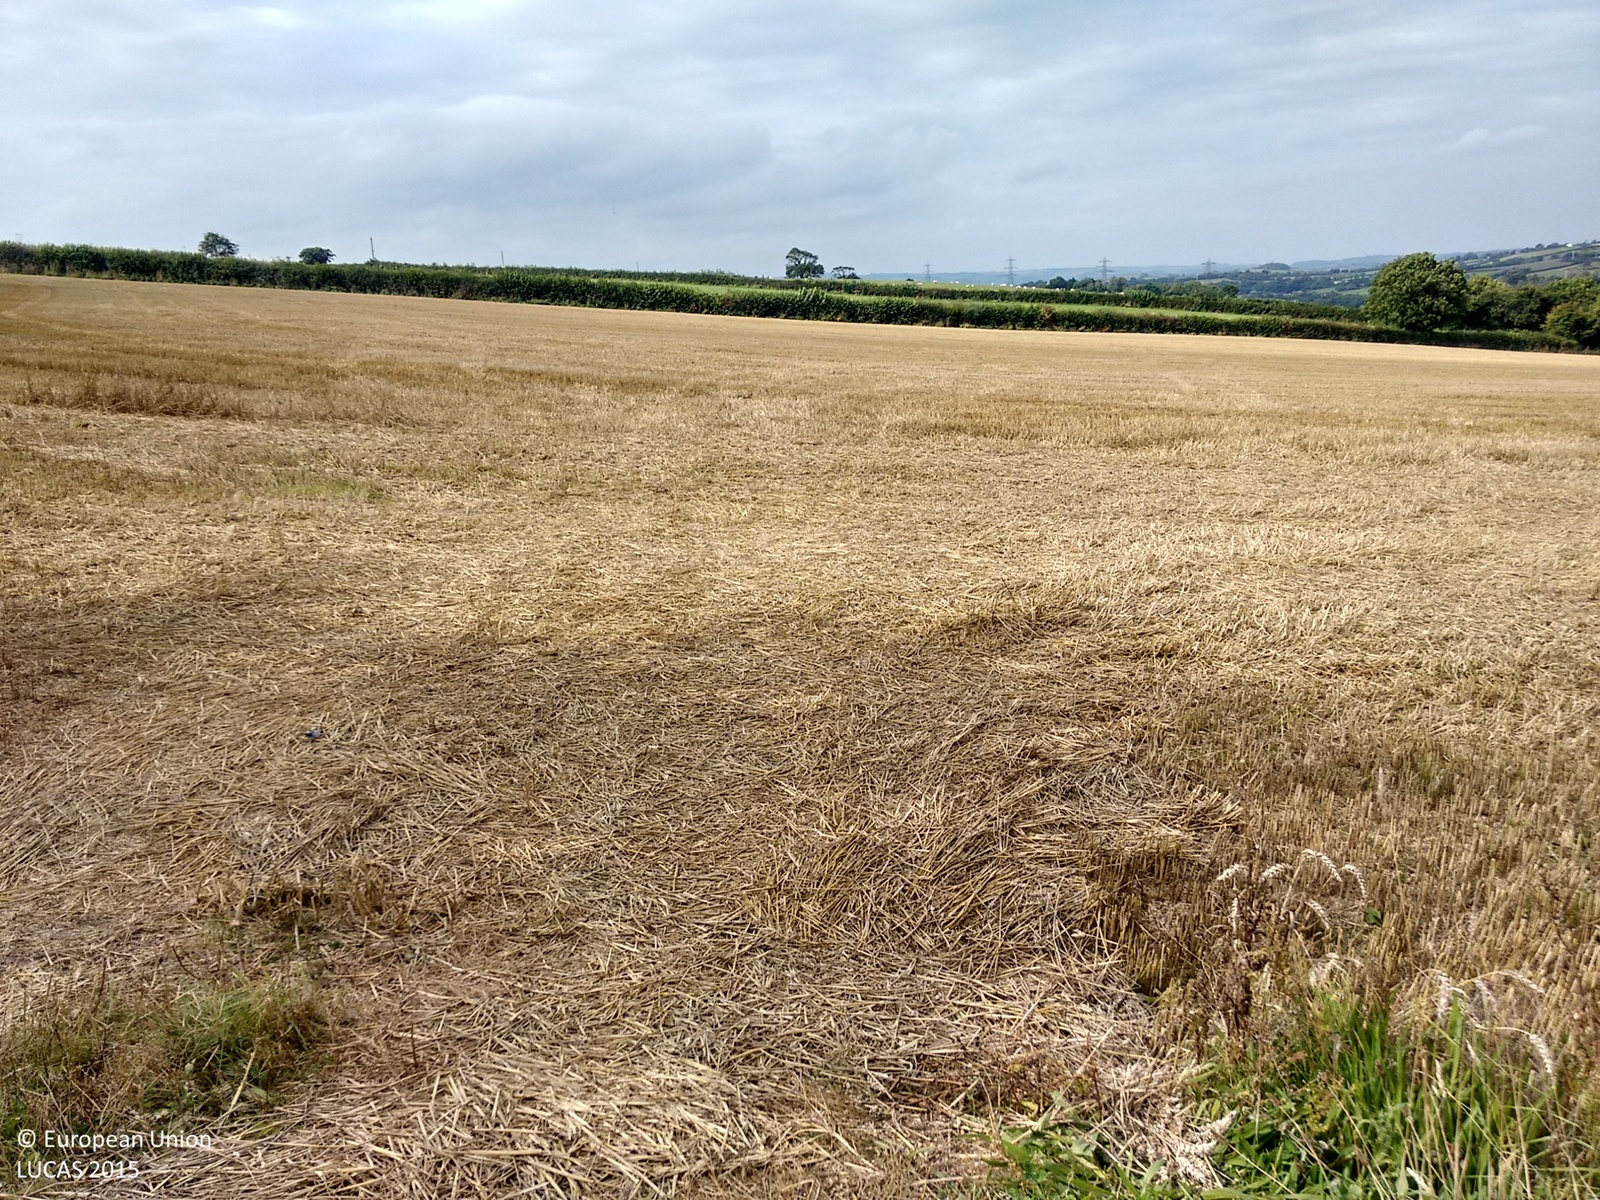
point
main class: Cropland
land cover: Barley
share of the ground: > 75 %
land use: Agriculture (excluding fallow land and kitchen gardens)
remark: Harvested field
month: September
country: GB
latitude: 51.0207
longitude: -3.9355
